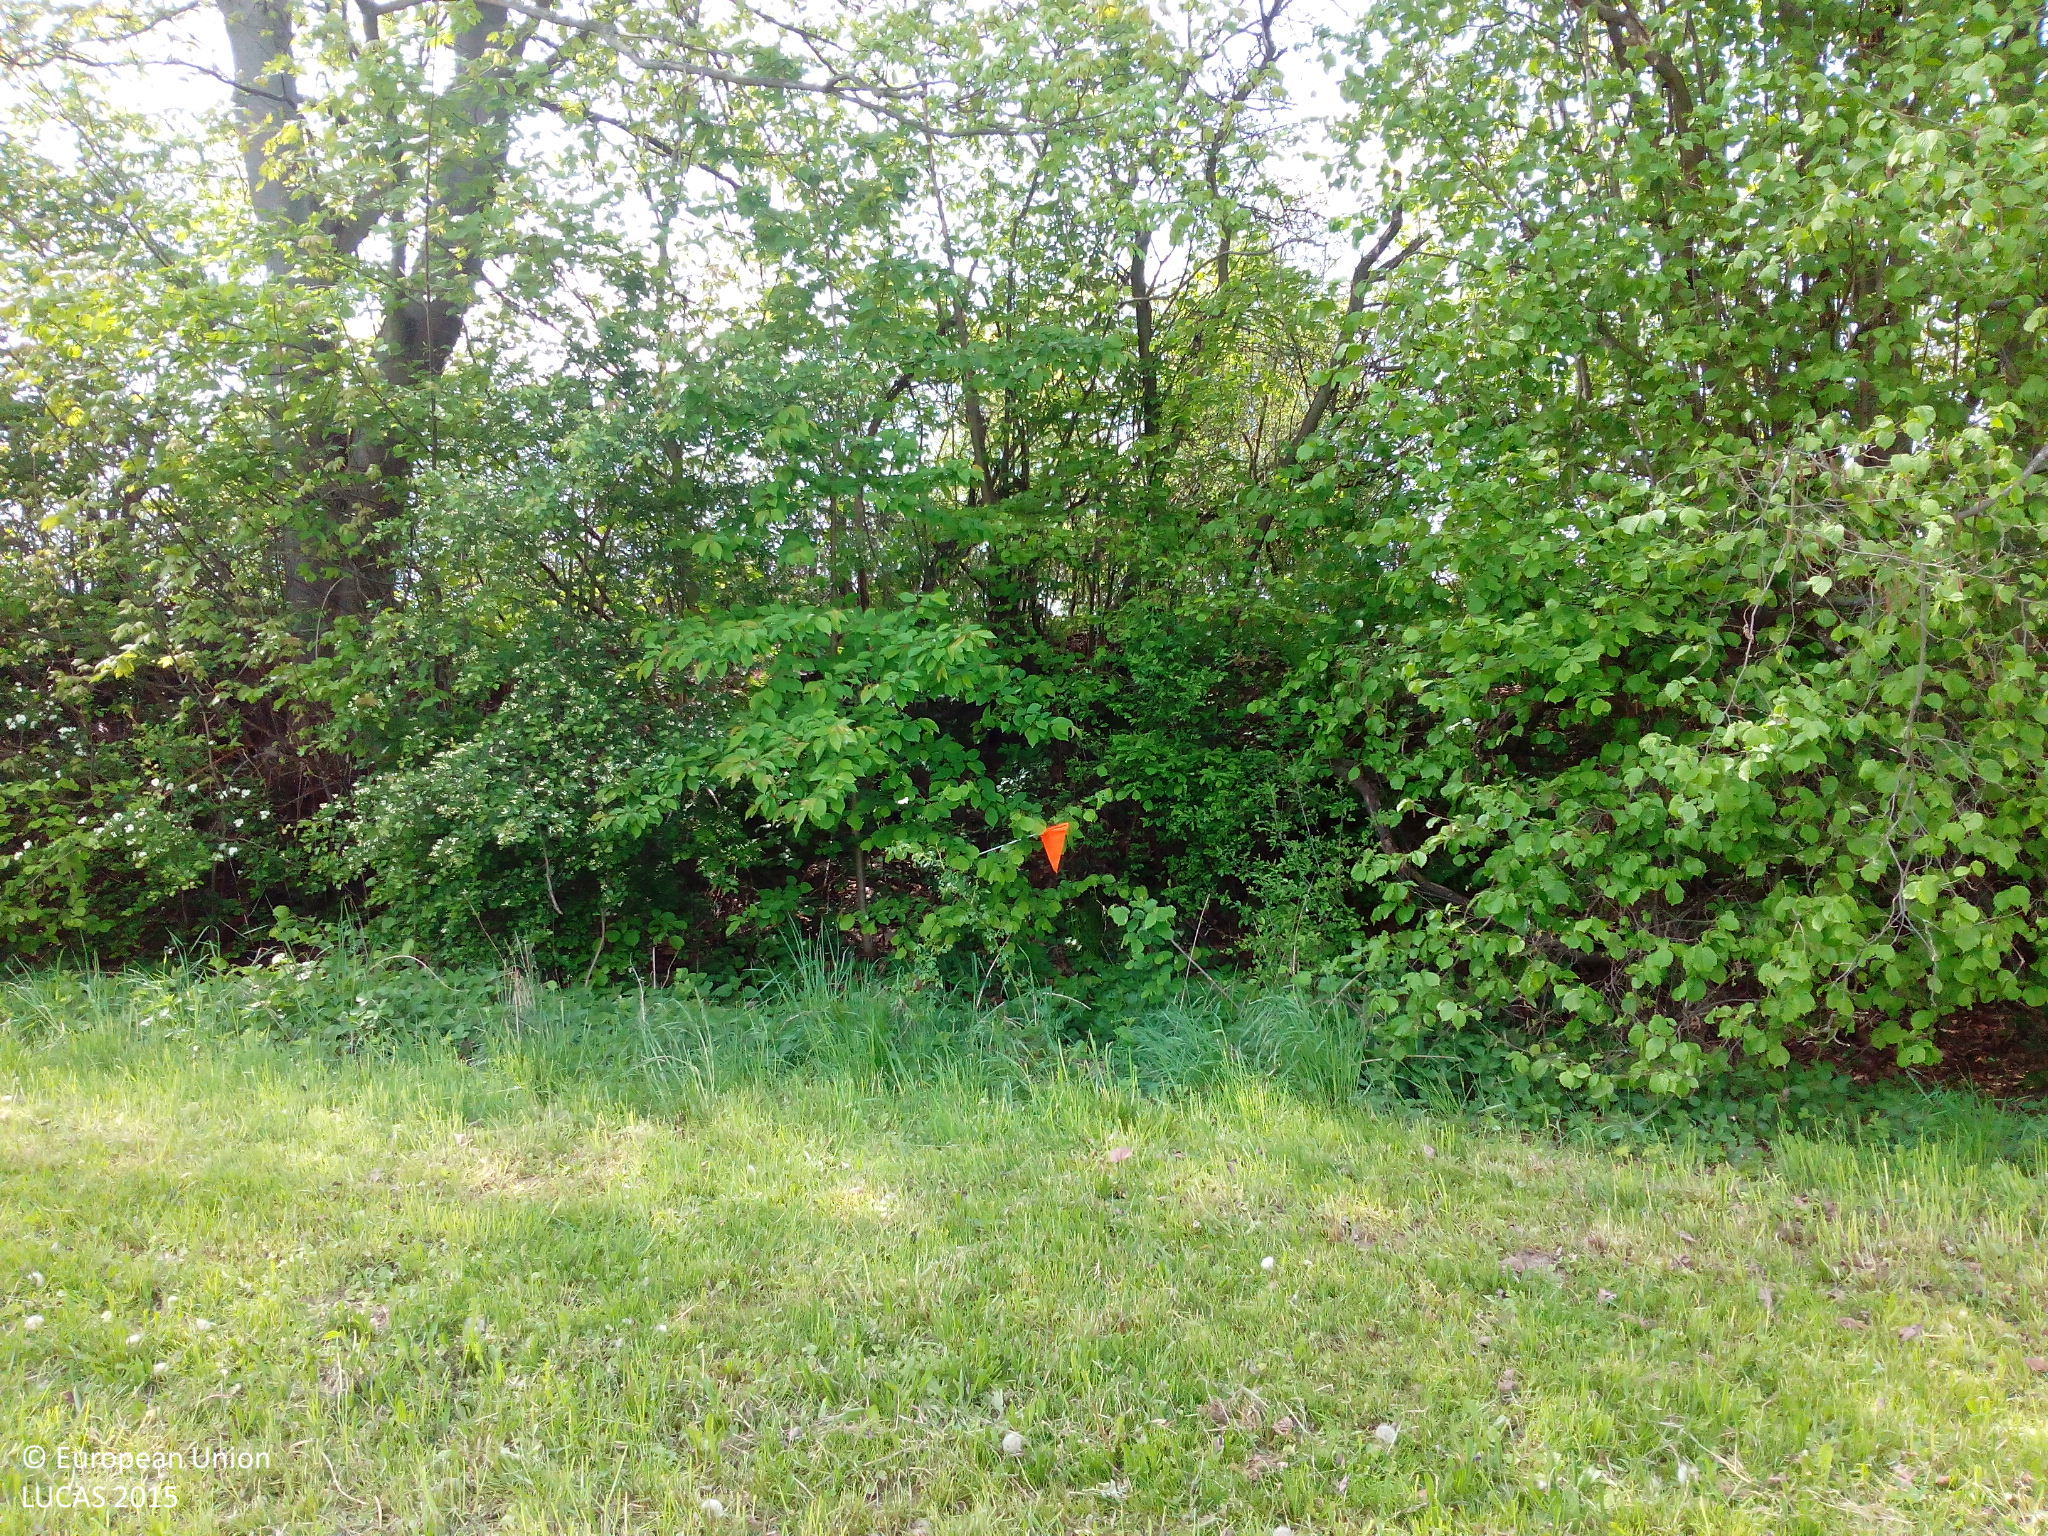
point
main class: Woodland
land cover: Broadleaved woodland
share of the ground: > 75 %
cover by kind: broadleaved forest trees 100 %
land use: Agriculture (excluding fallow land and kitchen gardens)
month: May
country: DE
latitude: 50.7725
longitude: 13.0772
